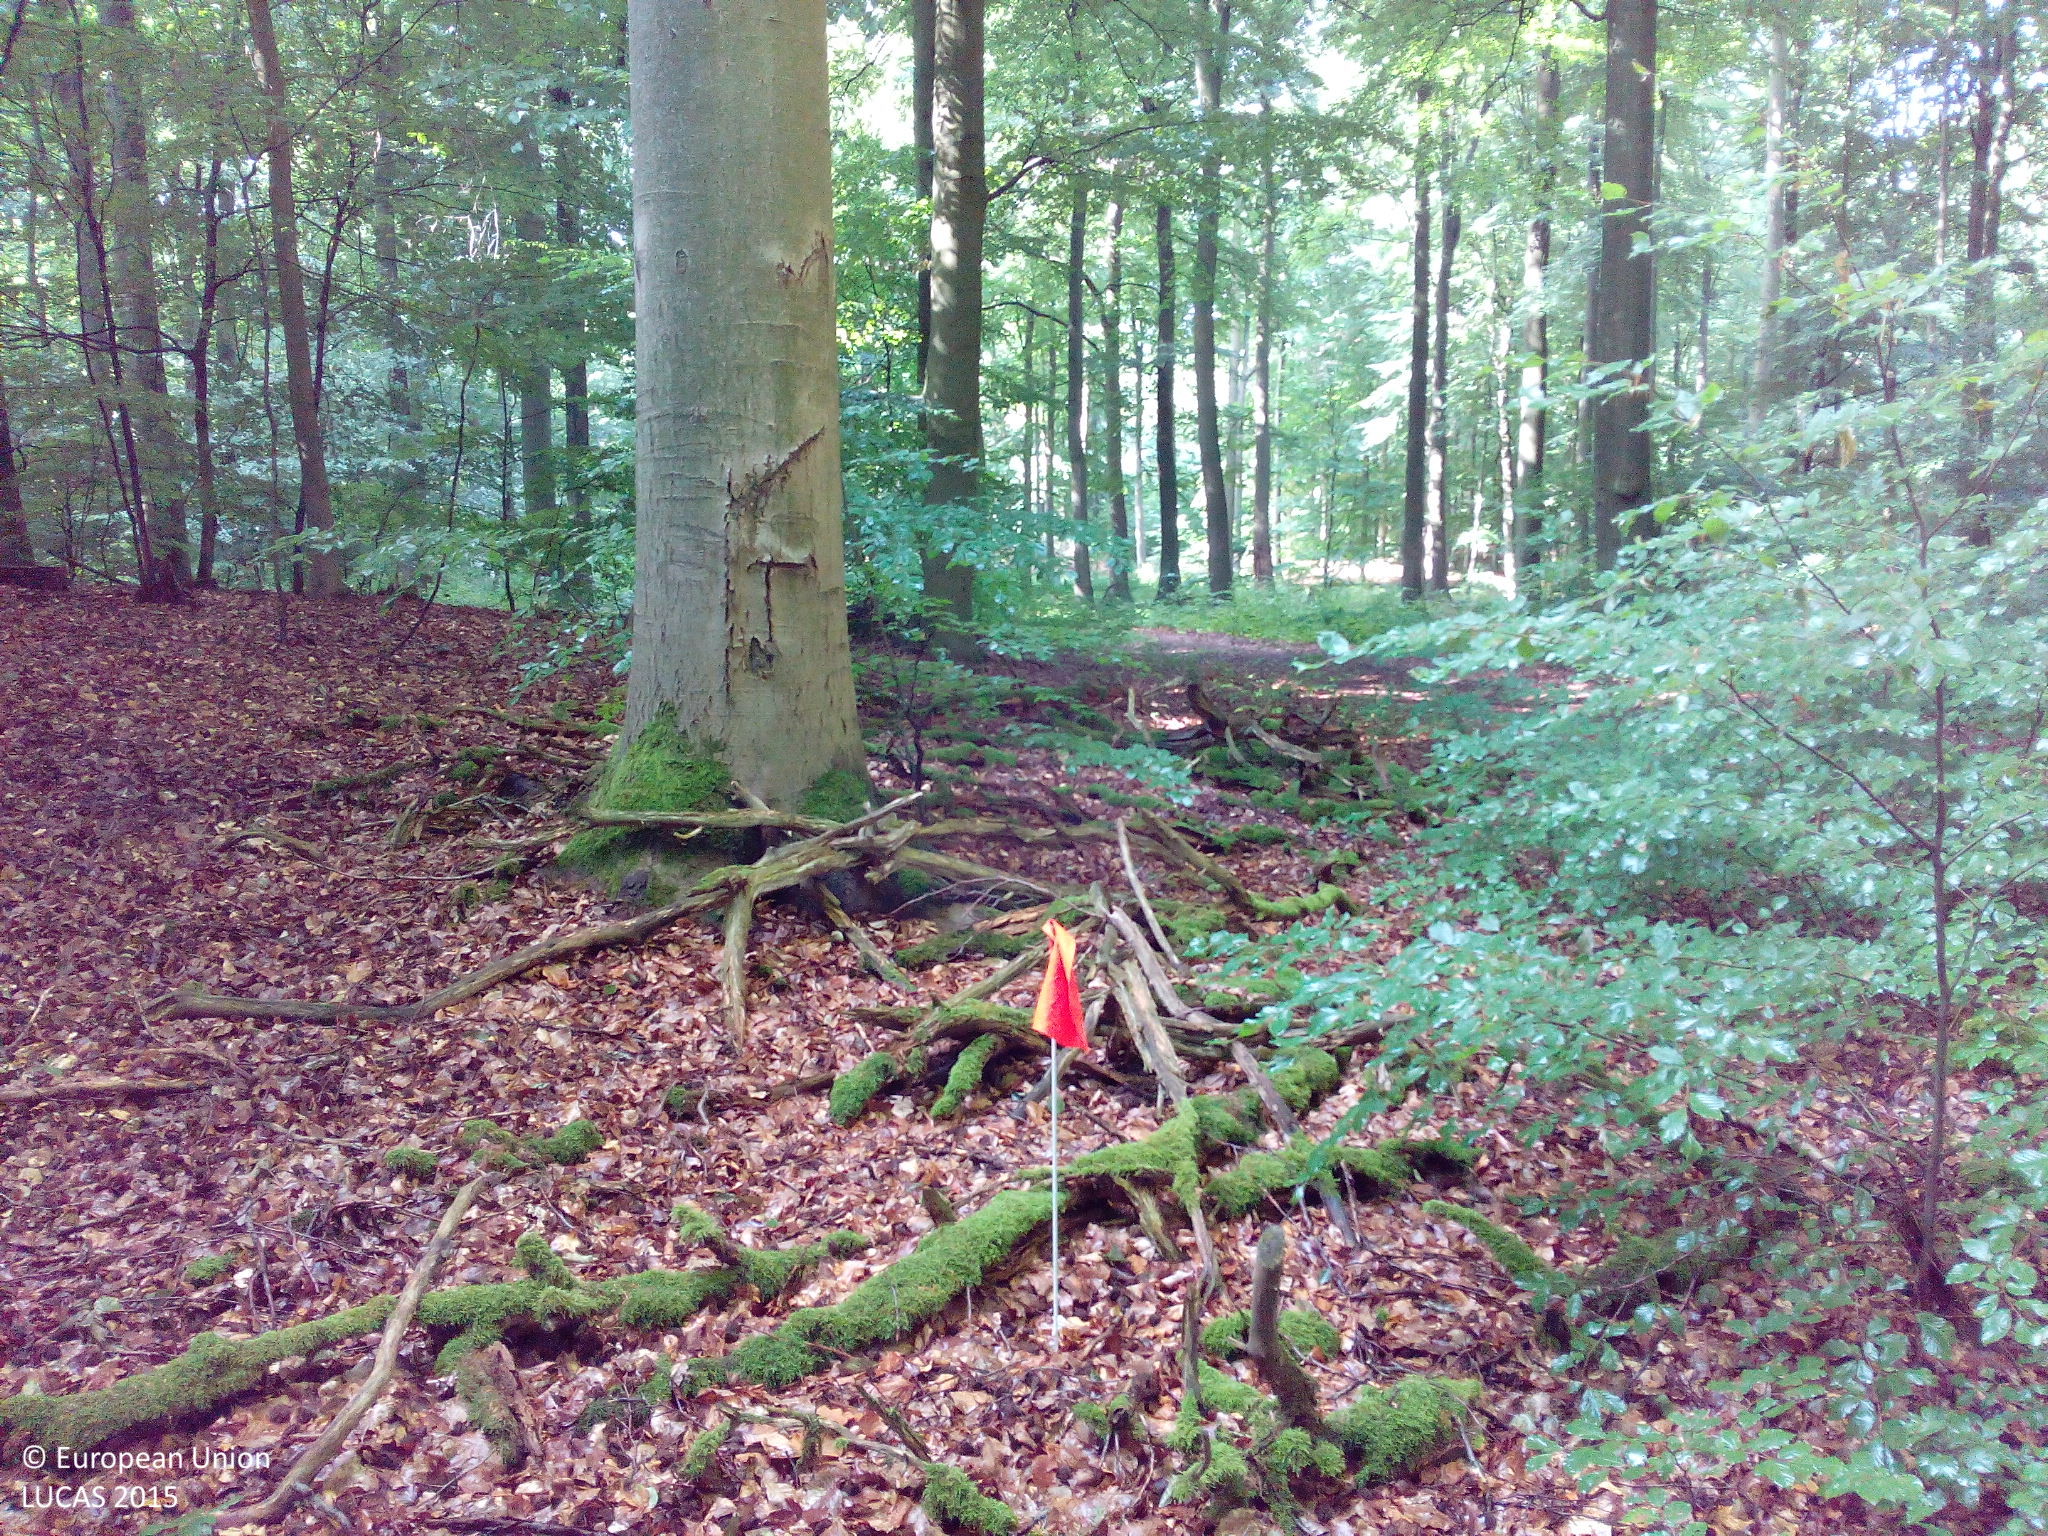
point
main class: Woodland
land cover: Broadleaved woodland
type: beech forest
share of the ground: > 75 %
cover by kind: broadleaved forest trees 90 %, unconsolidated bare surface 10 %
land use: Forestry
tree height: > 5 m
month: July
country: DE
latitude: 52.7744
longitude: 13.5429
